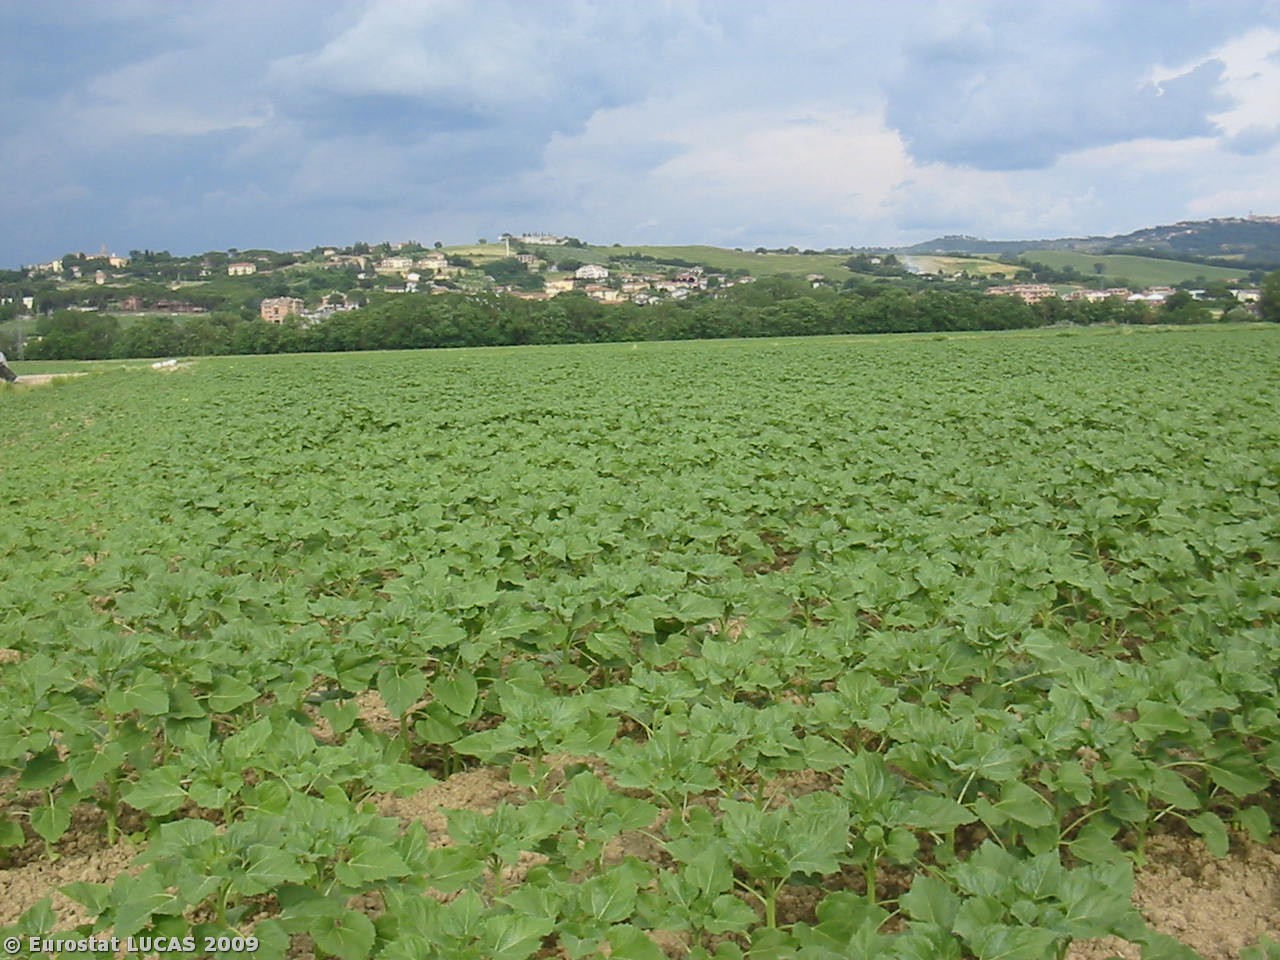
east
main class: Cropland
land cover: Sunflower
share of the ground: 50 - 75 %
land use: Agriculture (excluding fallow land and kitchen gardens)
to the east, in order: Sunflower; Grass margins; Paved roads, cycling and walking lanes; Grass margins; Other fresh vegetables
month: June
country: IT
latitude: 42.9151
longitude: 12.3815
